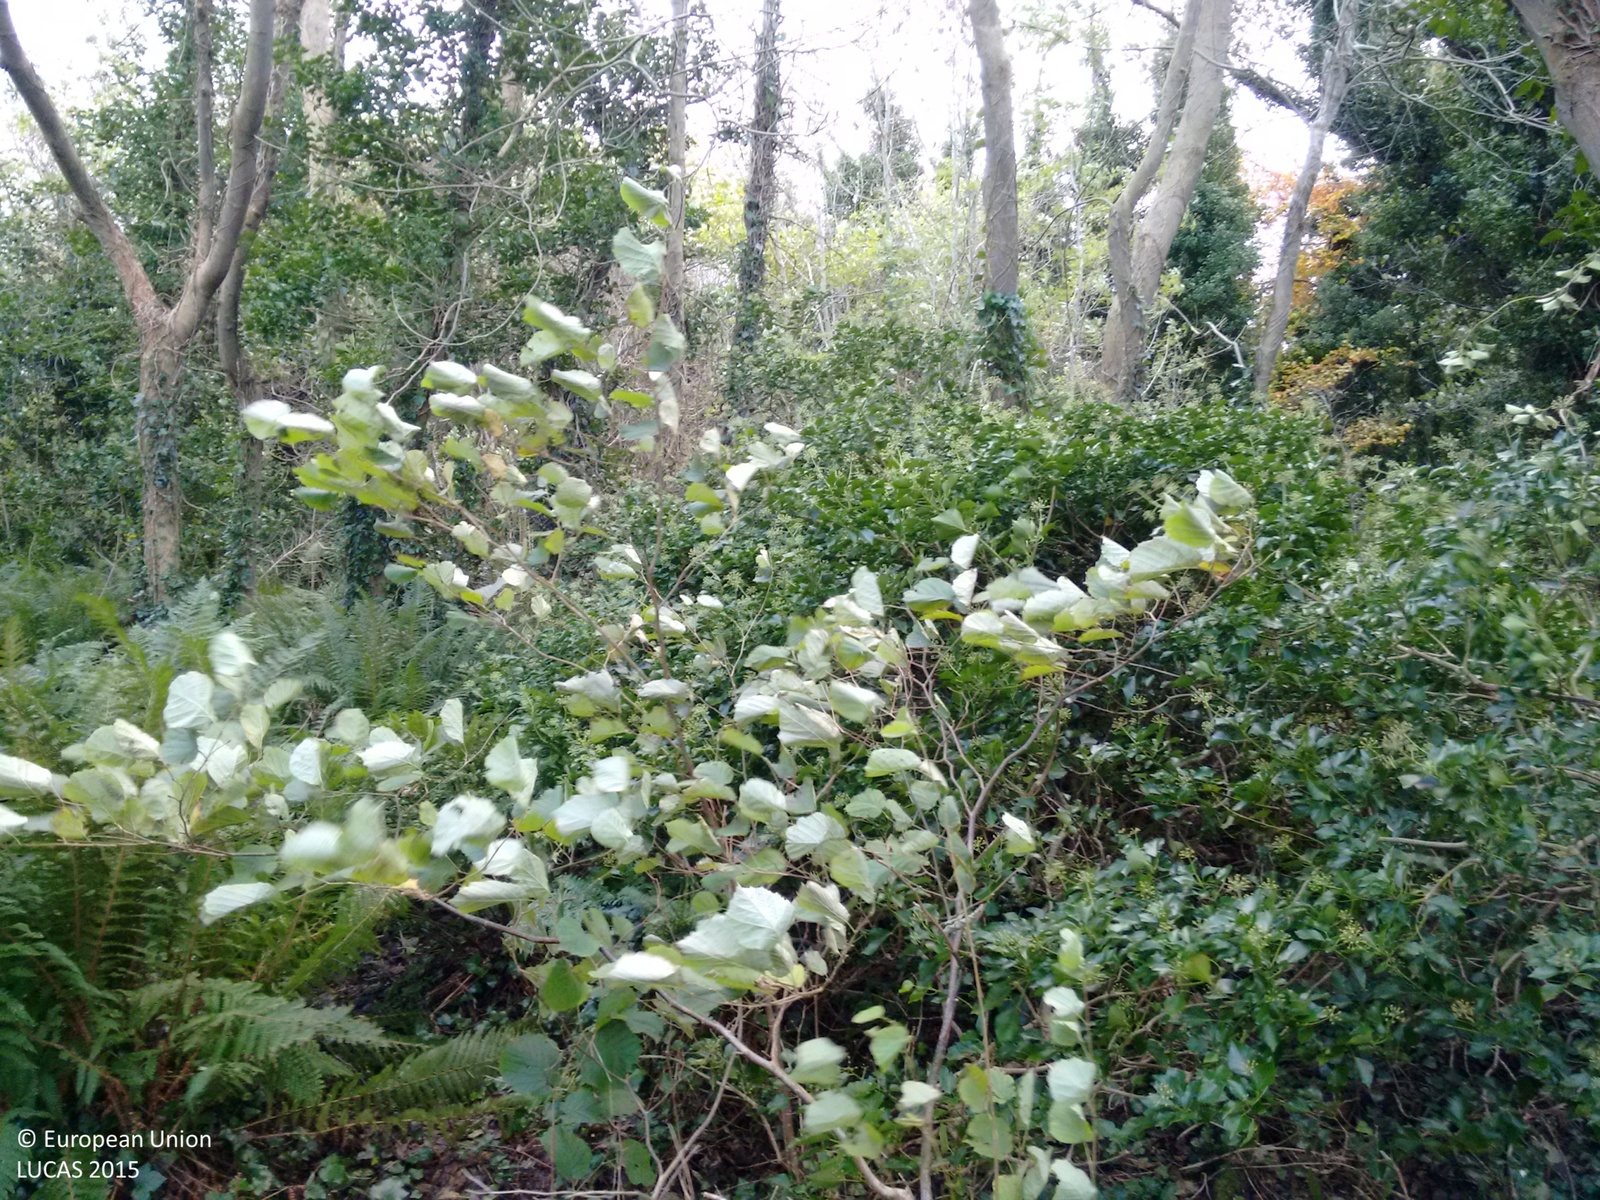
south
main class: Woodland
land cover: Broadleaved woodland
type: exotic forest
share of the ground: > 75 %
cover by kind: broadleaved forest trees 80 %, shrubs 10 %, herbaceous plants 10 %
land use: Semi-natural and natural areas not in use
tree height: > 5 m
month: November
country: GB
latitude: 54.6736
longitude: -5.7494
